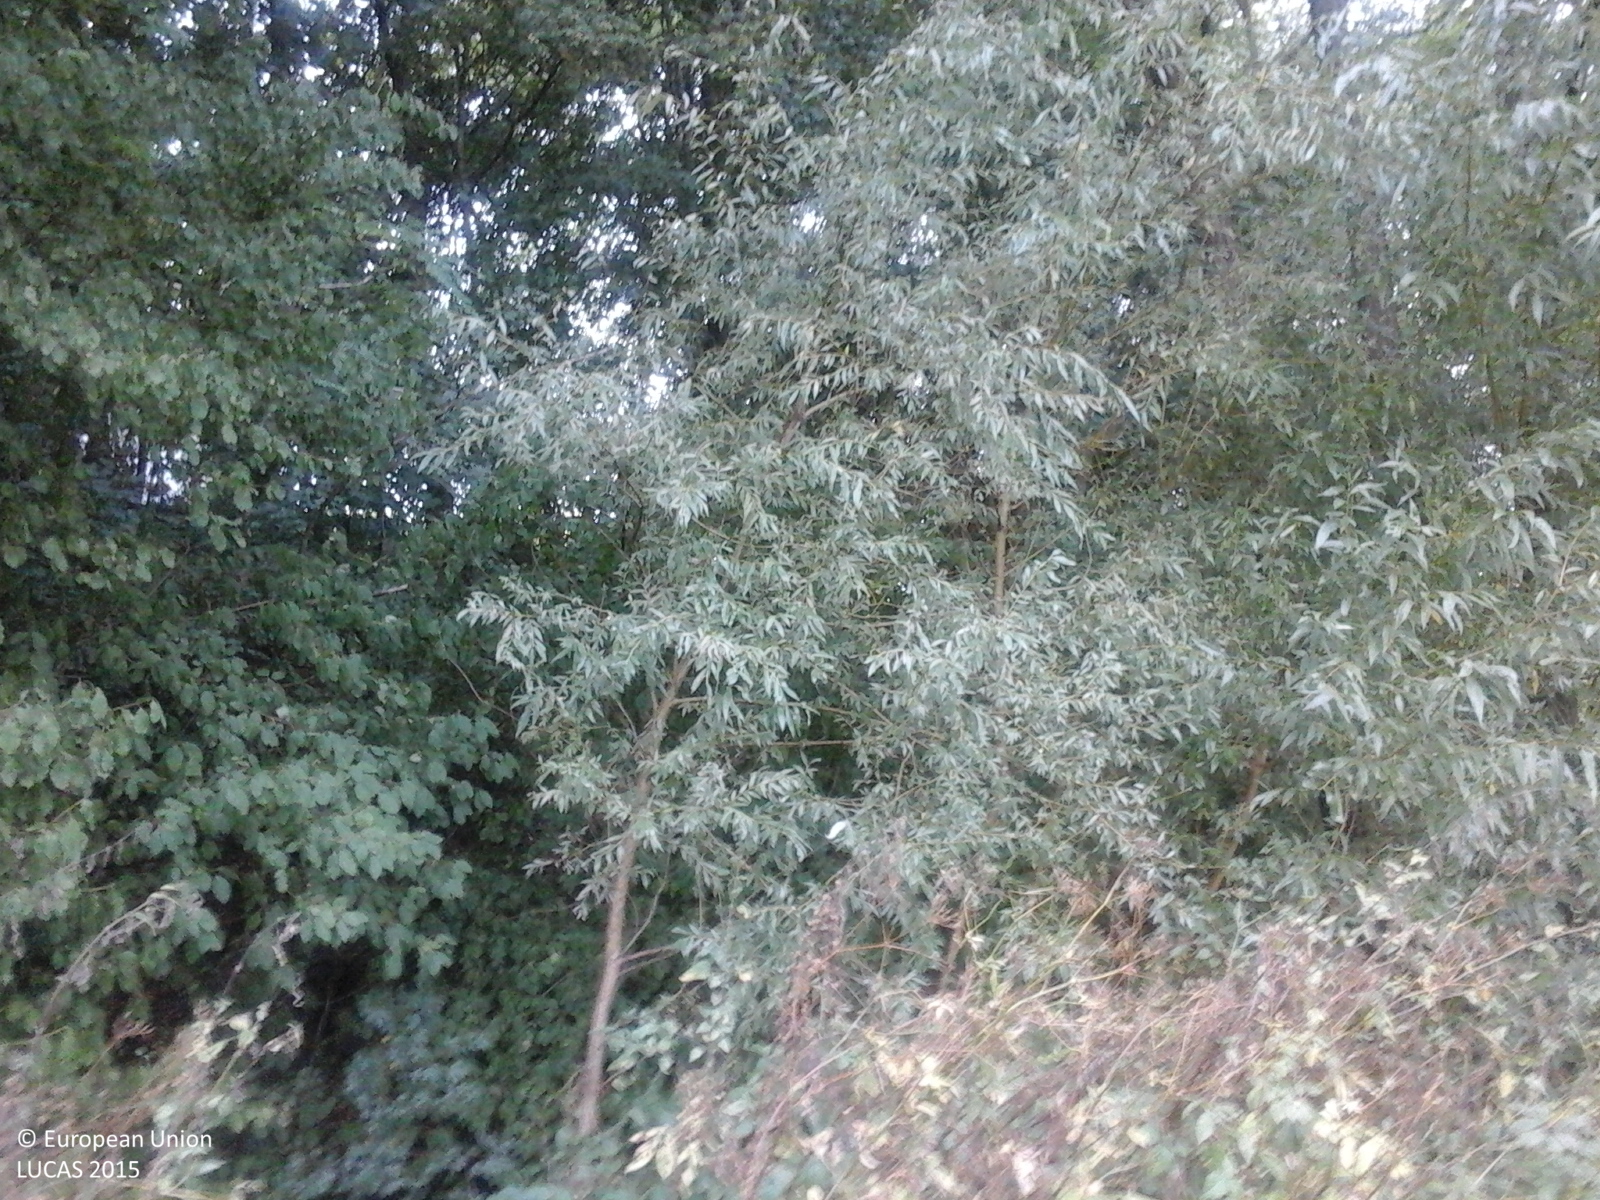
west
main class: Grassland
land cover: Grassland without tree/shrub cover
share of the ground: > 75 %
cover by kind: herbaceous plants 100 %
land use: Agriculture (excluding fallow land and kitchen gardens)
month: September
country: RO
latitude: 47.9710
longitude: 23.2119
